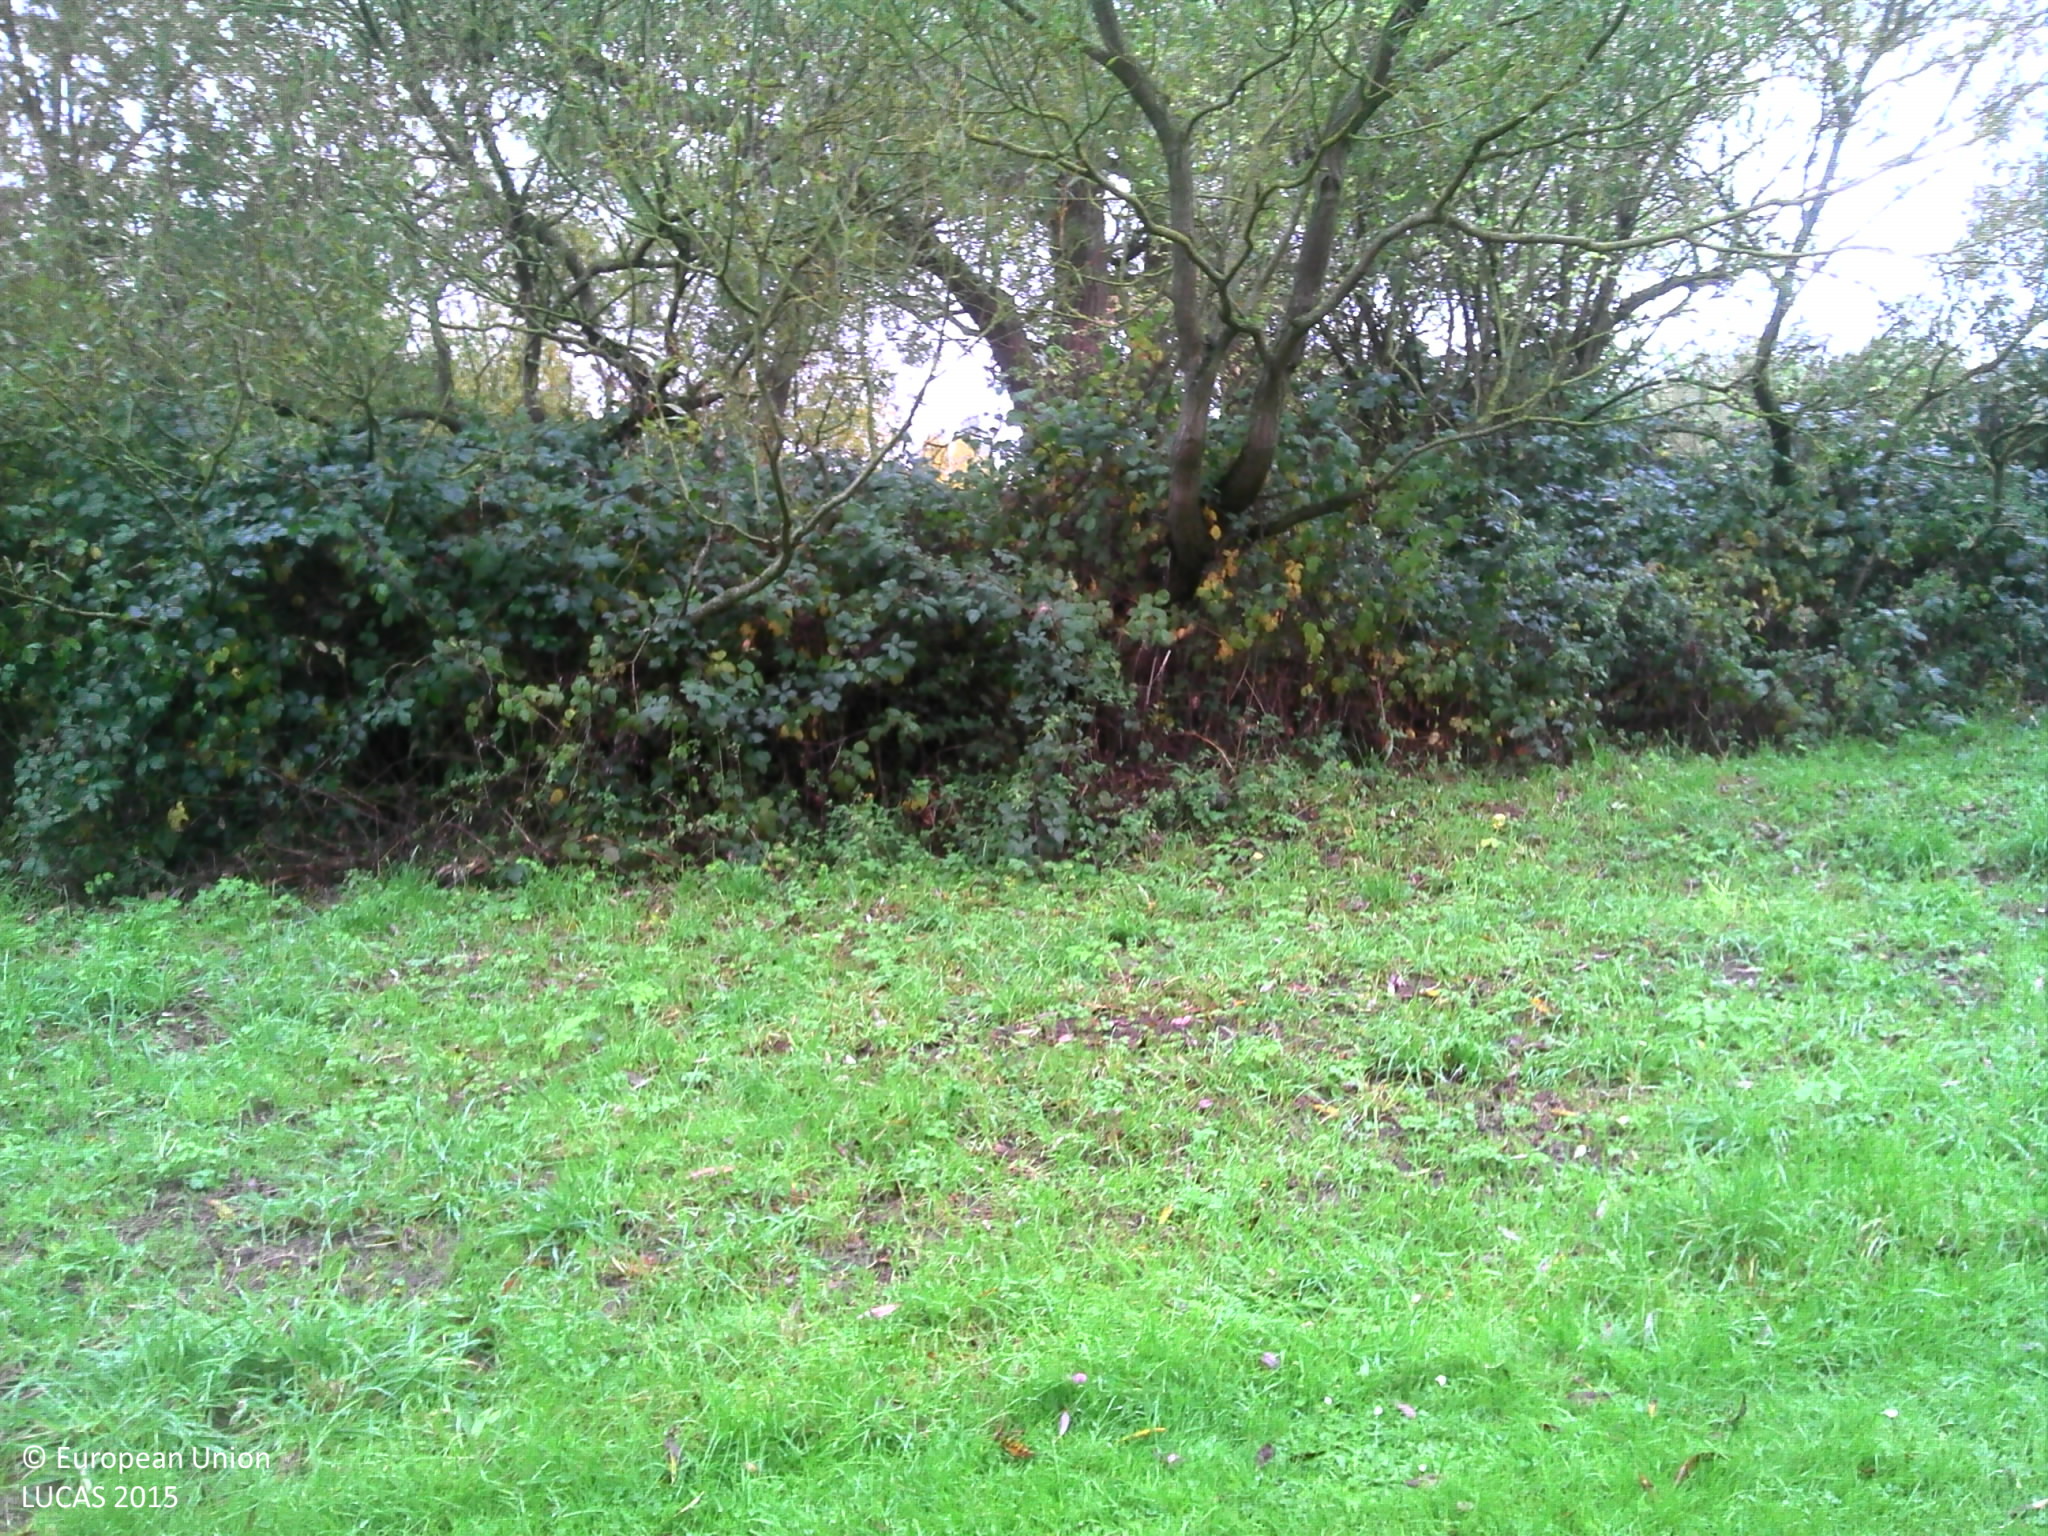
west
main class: Grassland
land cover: Grassland without tree/shrub cover
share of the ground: > 75 %
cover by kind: herbaceous plants 100 %
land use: Amenities, museums, leisure
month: October
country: BE
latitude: 50.8528
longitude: 4.2991
